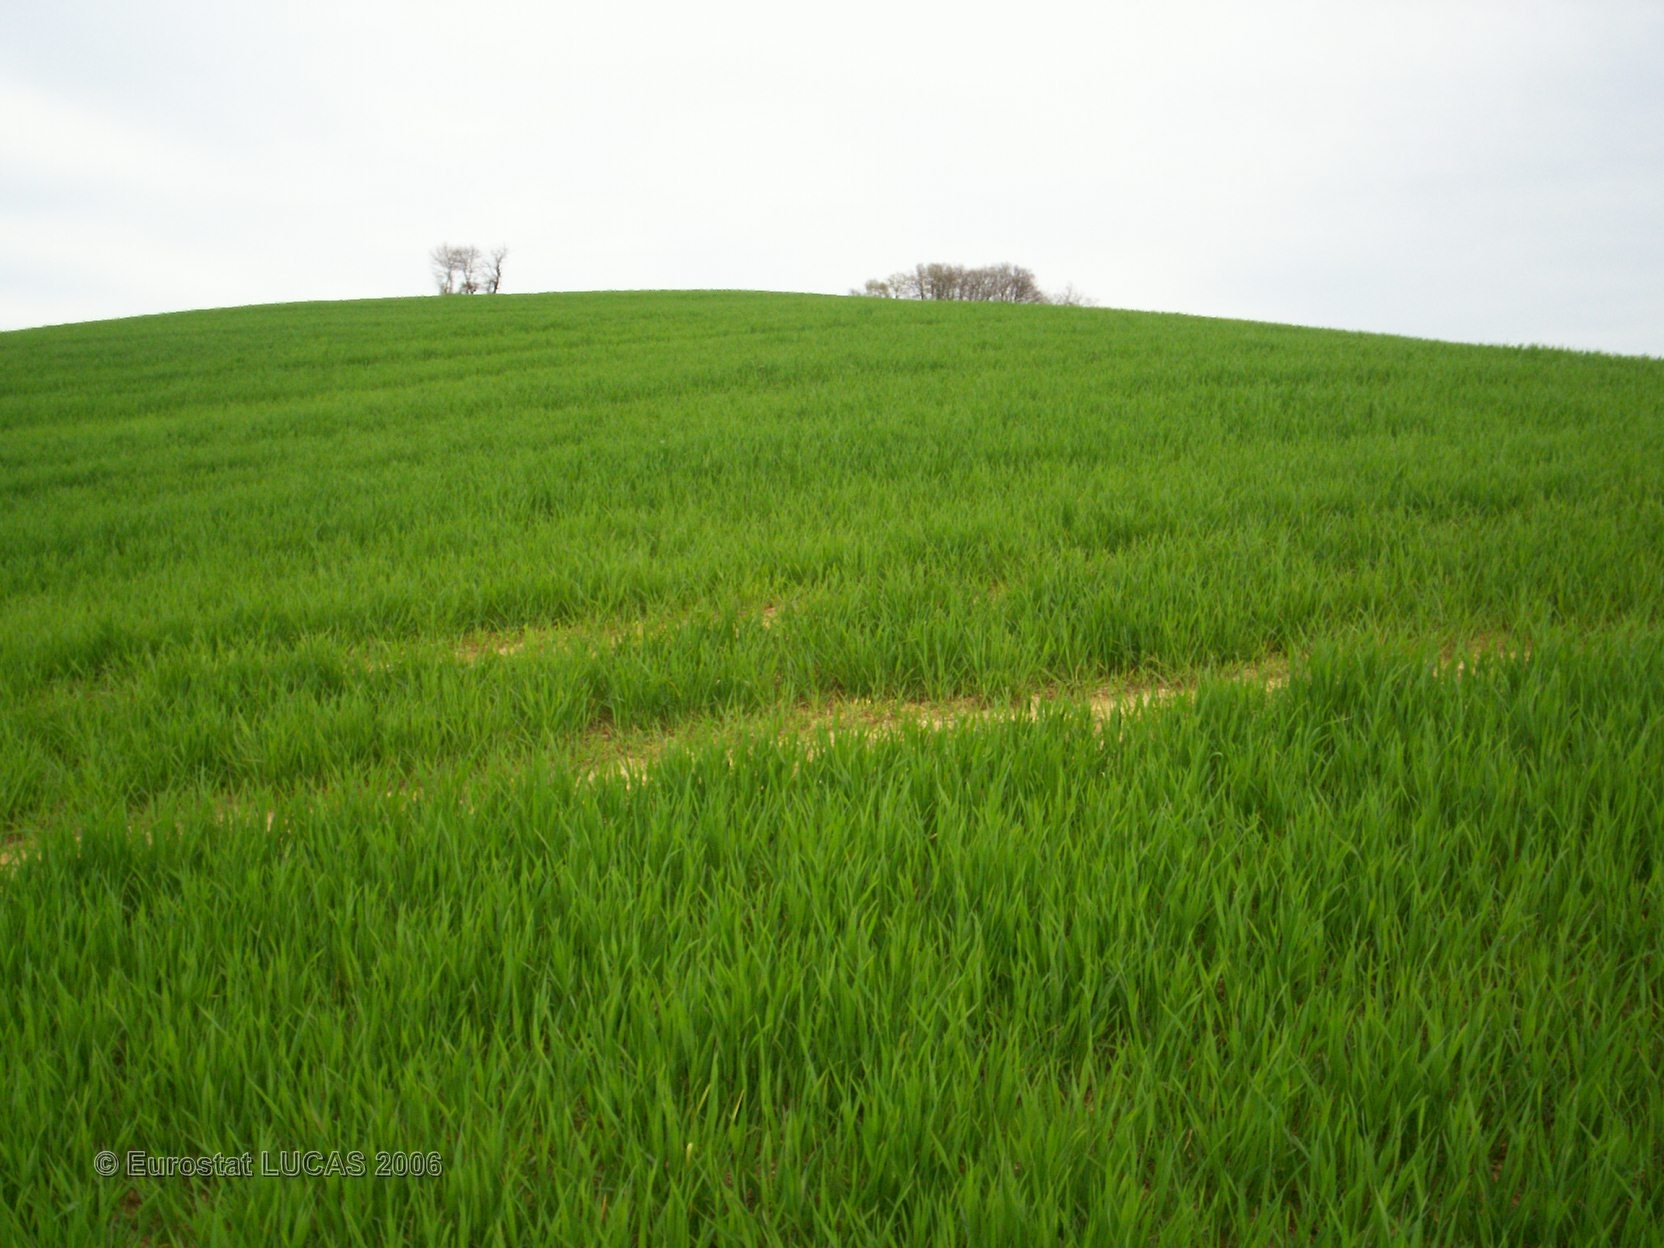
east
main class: Cropland
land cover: Common wheat
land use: Agriculture (excluding fallow land and kitchen gardens)
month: April
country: FR
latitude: 43.6578
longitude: 0.2866
